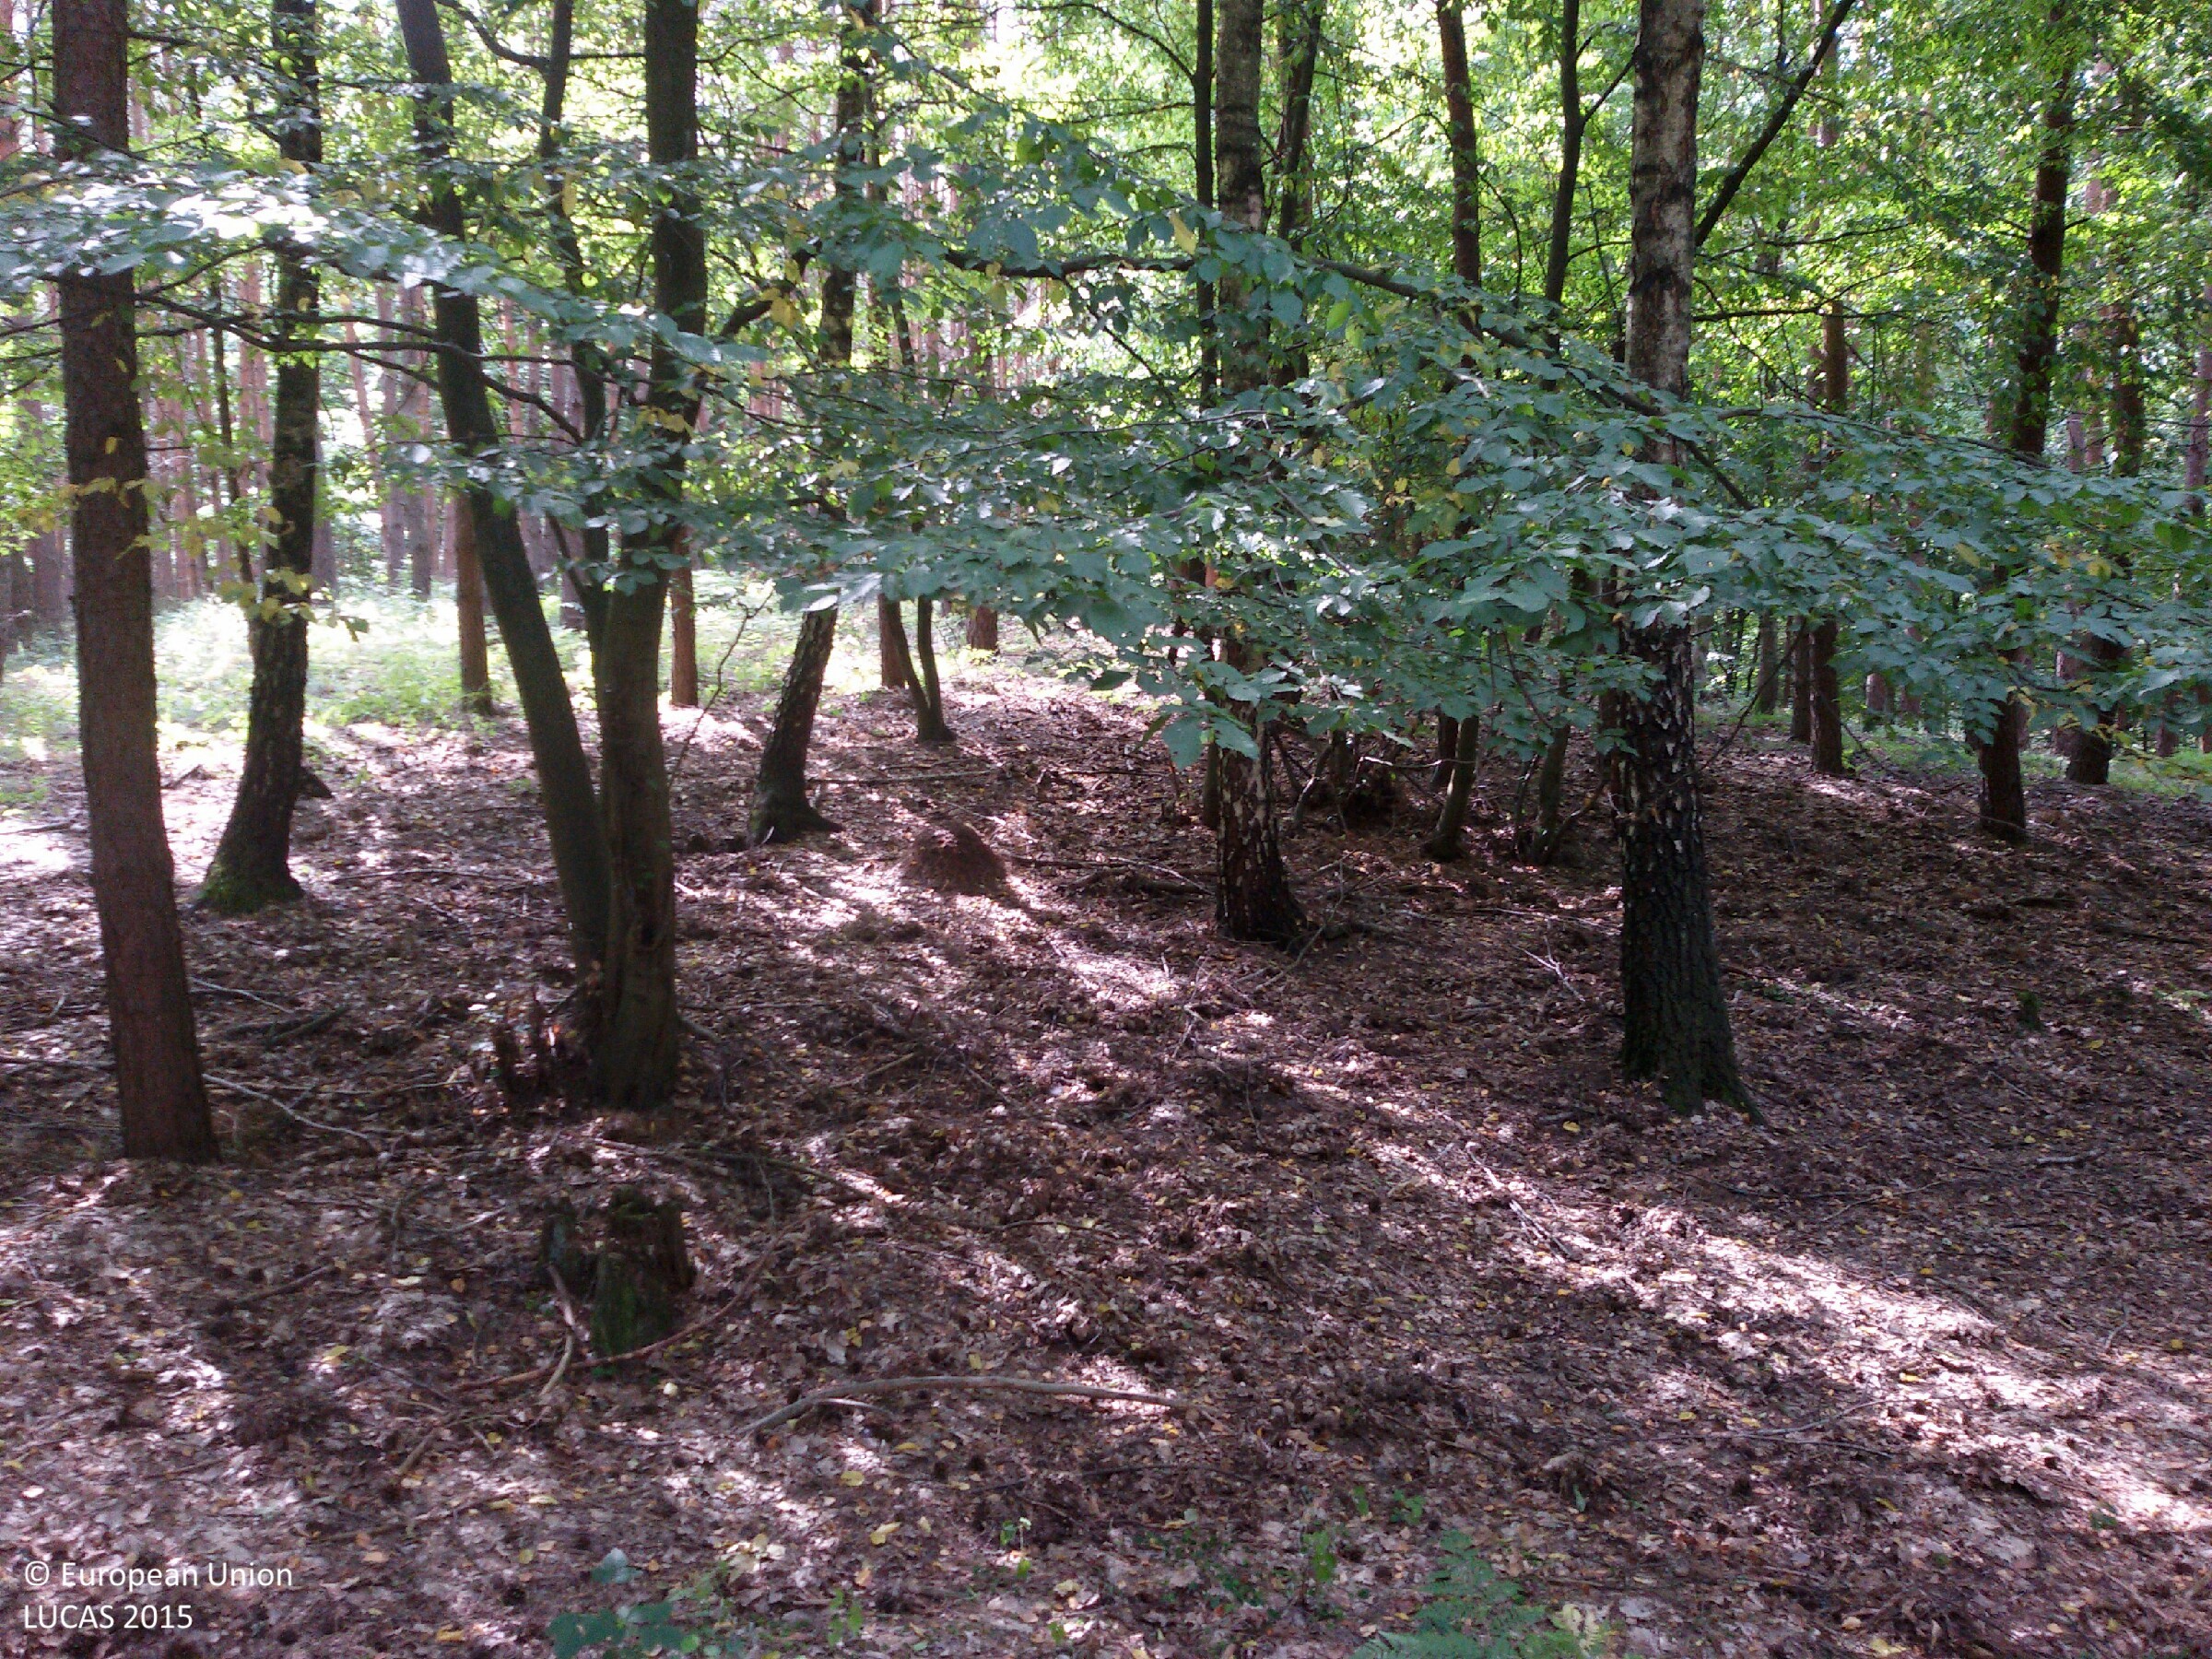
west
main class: Woodland
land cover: Pine dominated coniferous woodland
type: hemiboreal forest and nemoral coniferous forest and mixed broadleaved-coniferous forest
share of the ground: > 75 %
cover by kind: coniferous forest trees 80 %, broadleaved forest trees 15 %, shrubs 5 %
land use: Forestry
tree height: > 5 m
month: August
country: PL
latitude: 52.9307
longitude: 14.2706
